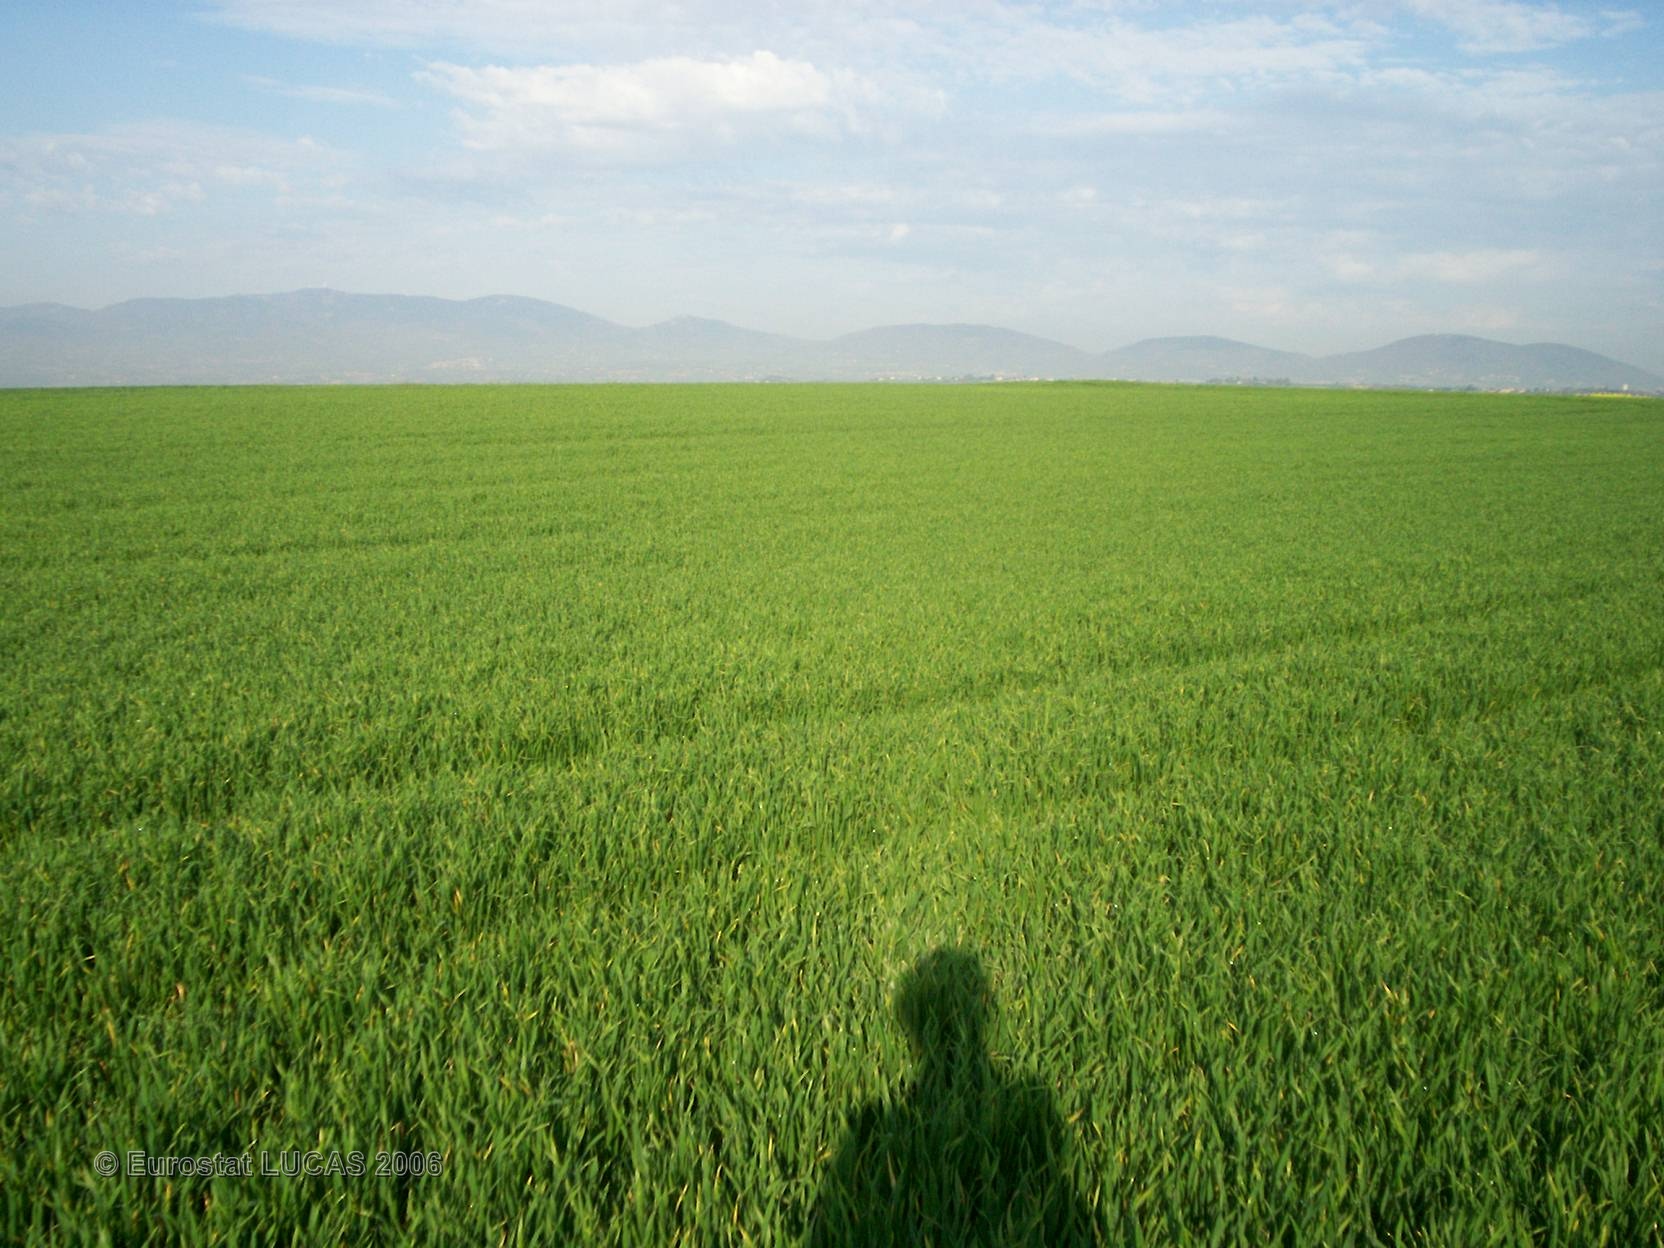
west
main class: Cropland
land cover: Common wheat
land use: Agriculture (excluding fallow land and kitchen gardens)
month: April
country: FR
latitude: 45.4510
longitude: 4.8513
